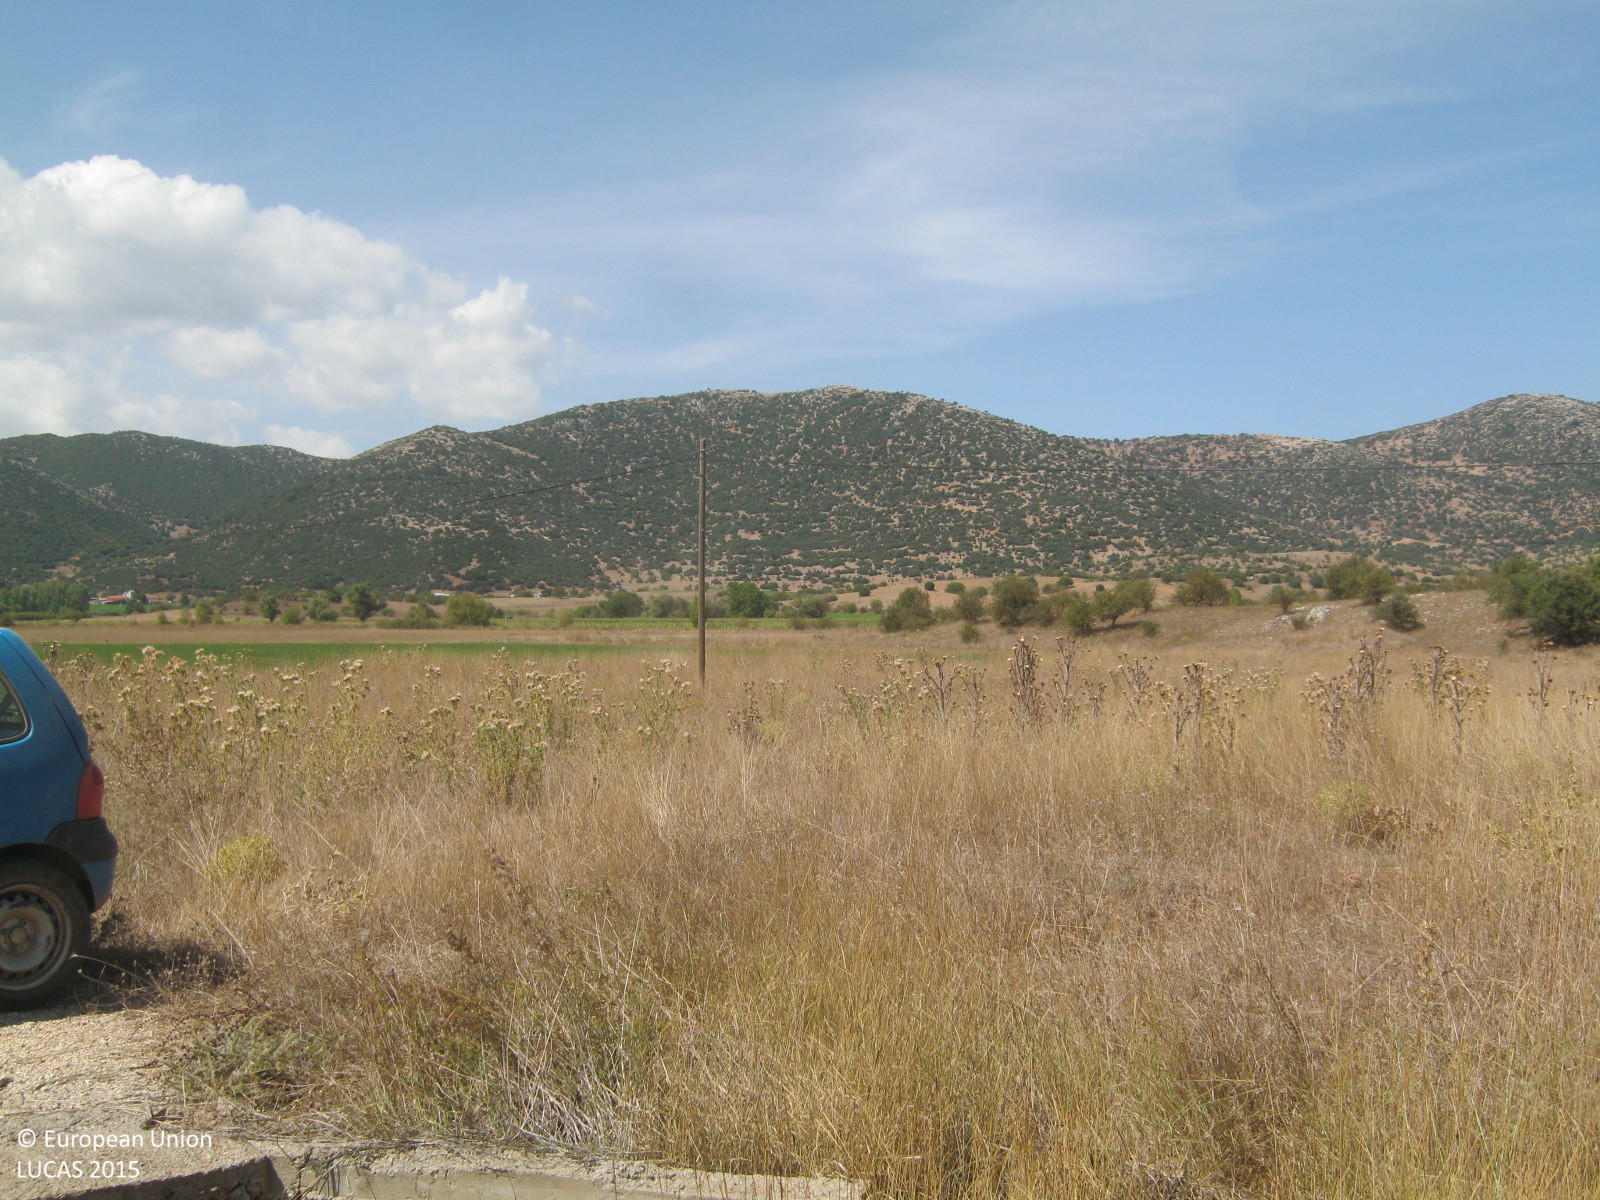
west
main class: Grassland
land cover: Spontaneously vegetated surfaces
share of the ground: > 75 %
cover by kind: herbaceous plants 95 %, unconsolidated bare surface 5 %
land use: Fallow land
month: September
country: GR
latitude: 37.9773
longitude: 22.1136
